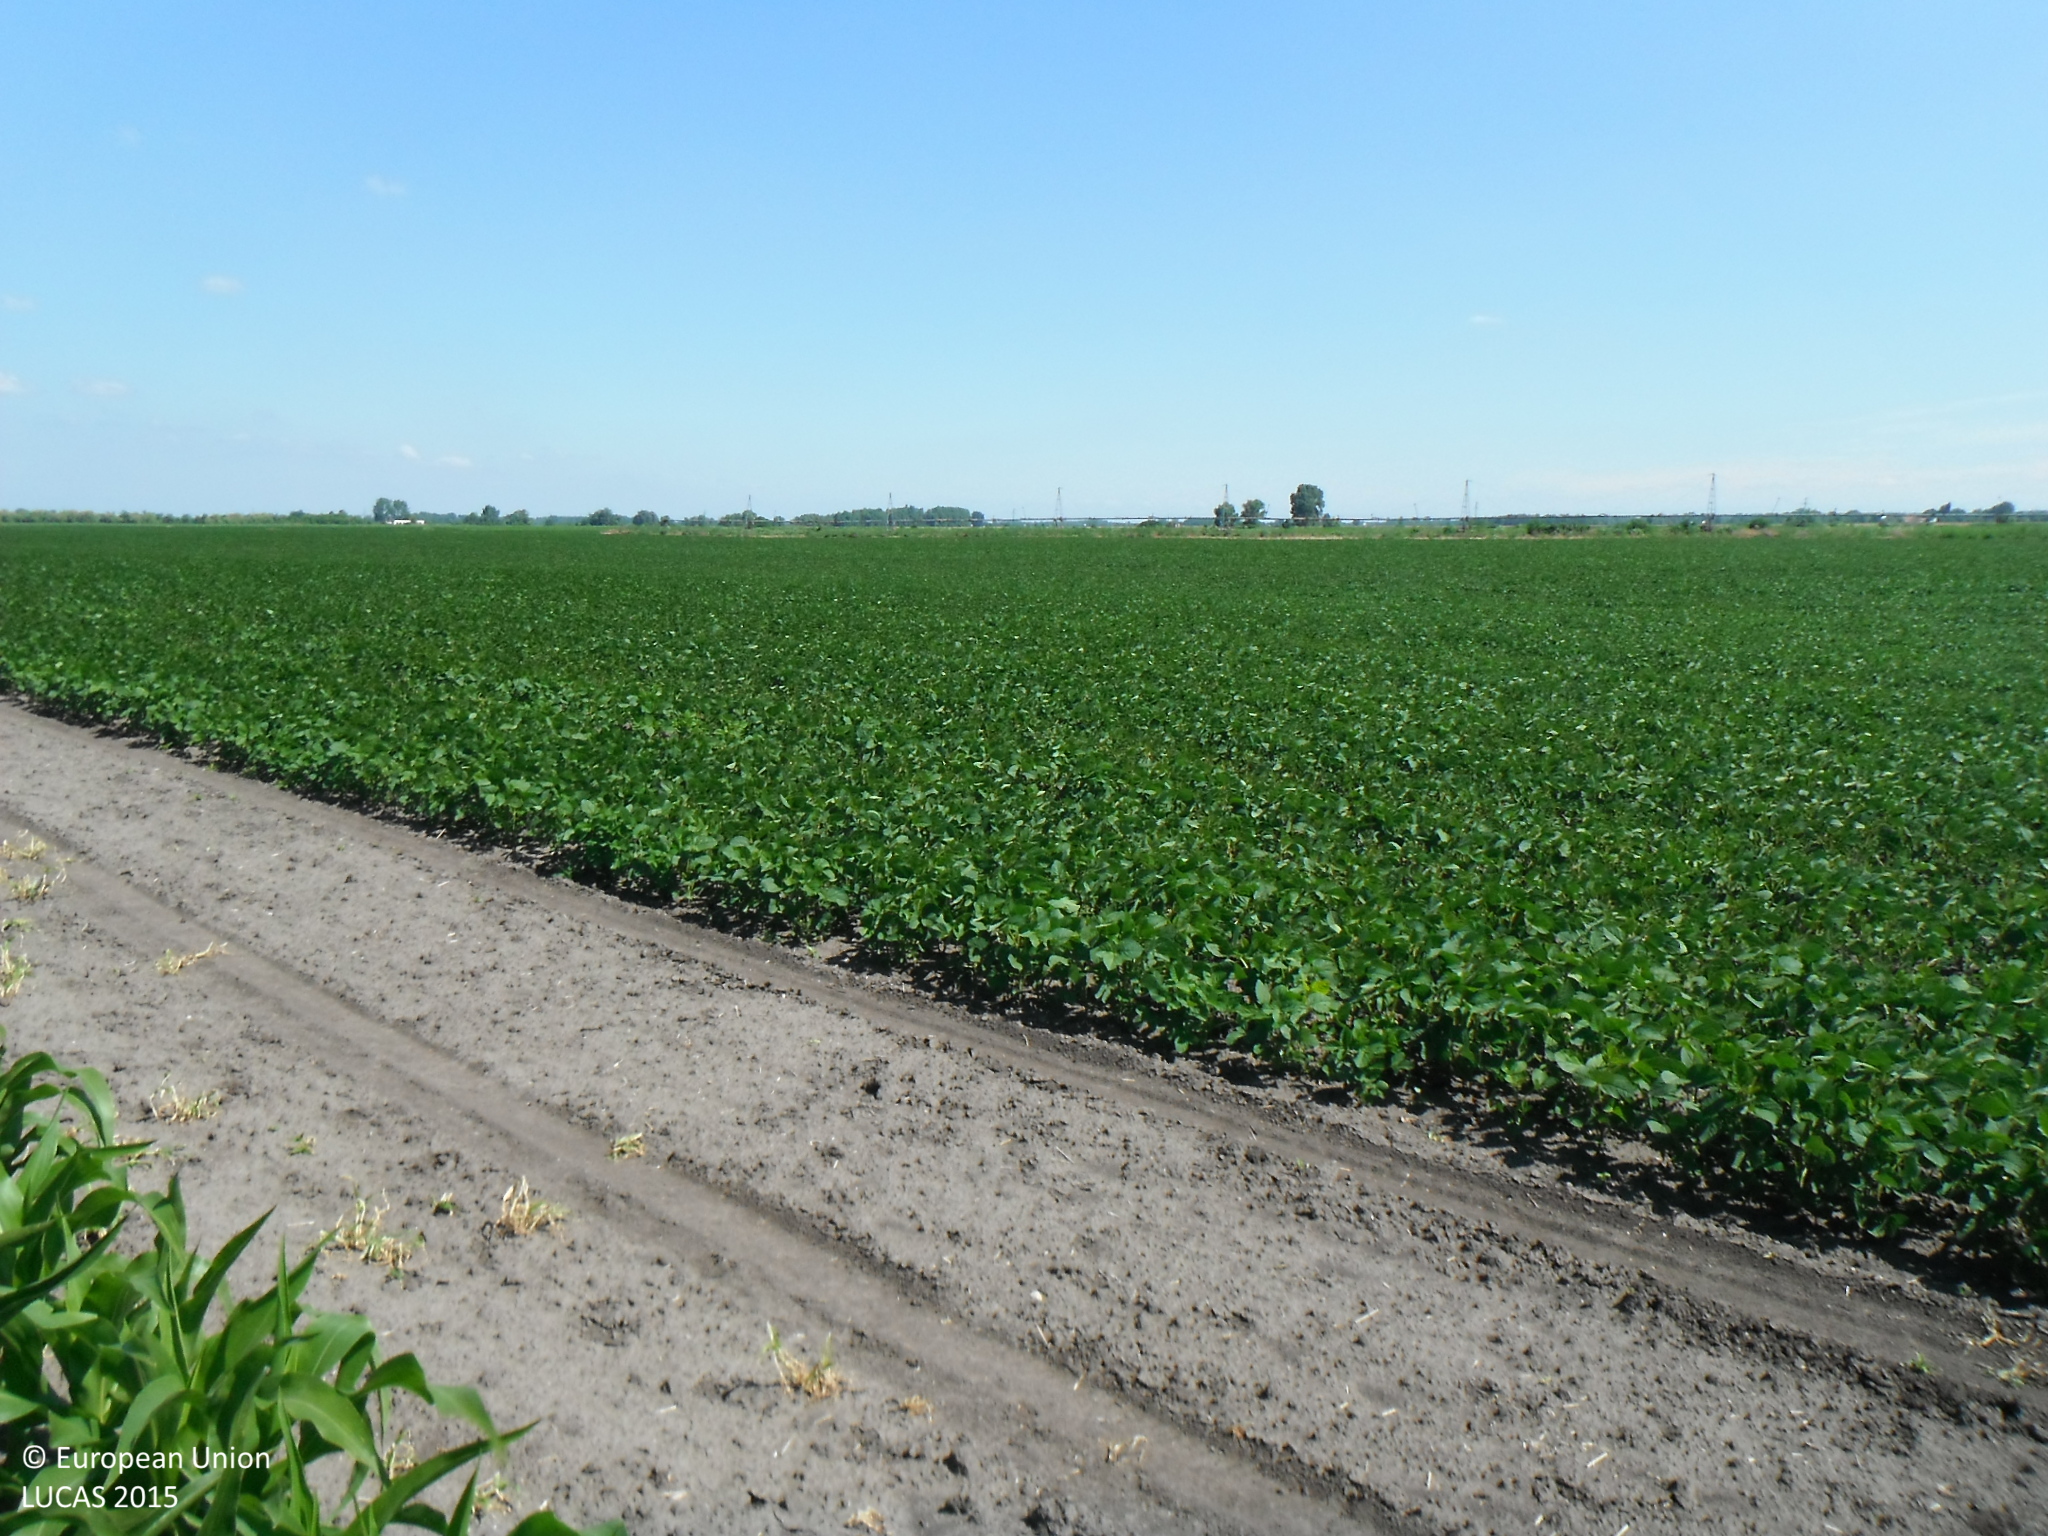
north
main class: Cropland
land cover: Maize
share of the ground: 50 - 75 %
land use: Agriculture (excluding fallow land and kitchen gardens)
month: June
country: SK
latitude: 47.7934
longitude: 18.1693
